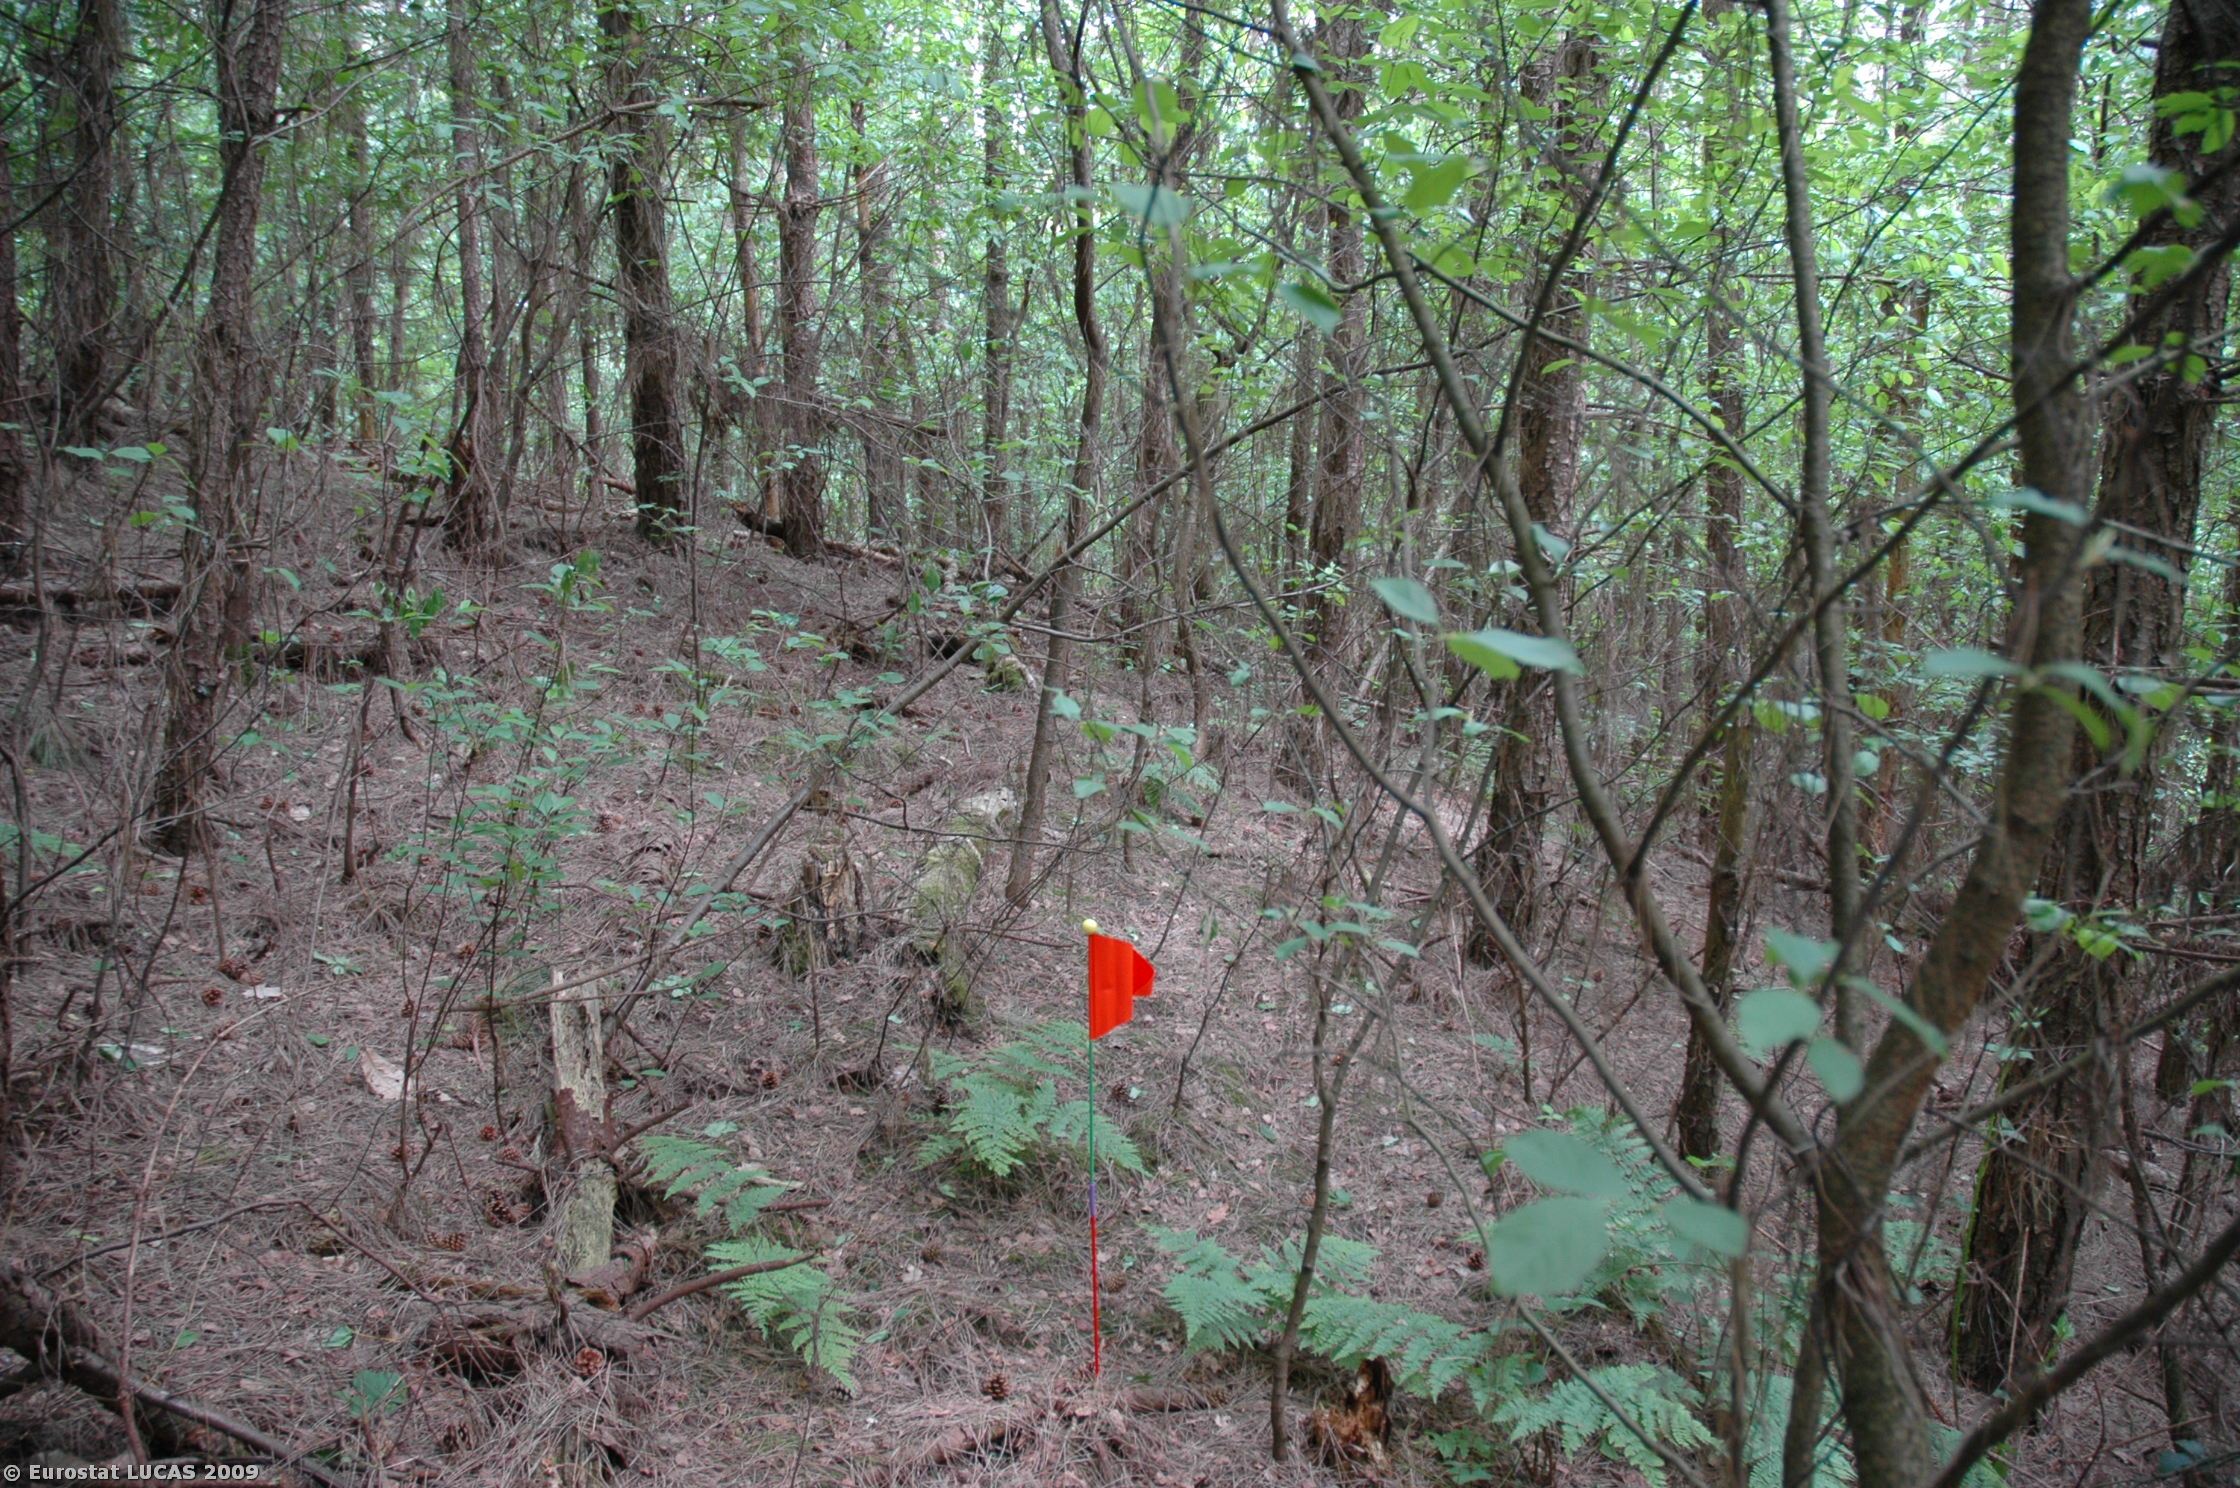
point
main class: Woodland
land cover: Mixed woodland
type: hemiboreal forest and nemoral coniferous forest and mixed broadleaved-coniferous forest
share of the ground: > 75 %
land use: Unused
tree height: > 5 m
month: May
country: NL
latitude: 52.0198
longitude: 5.4371
